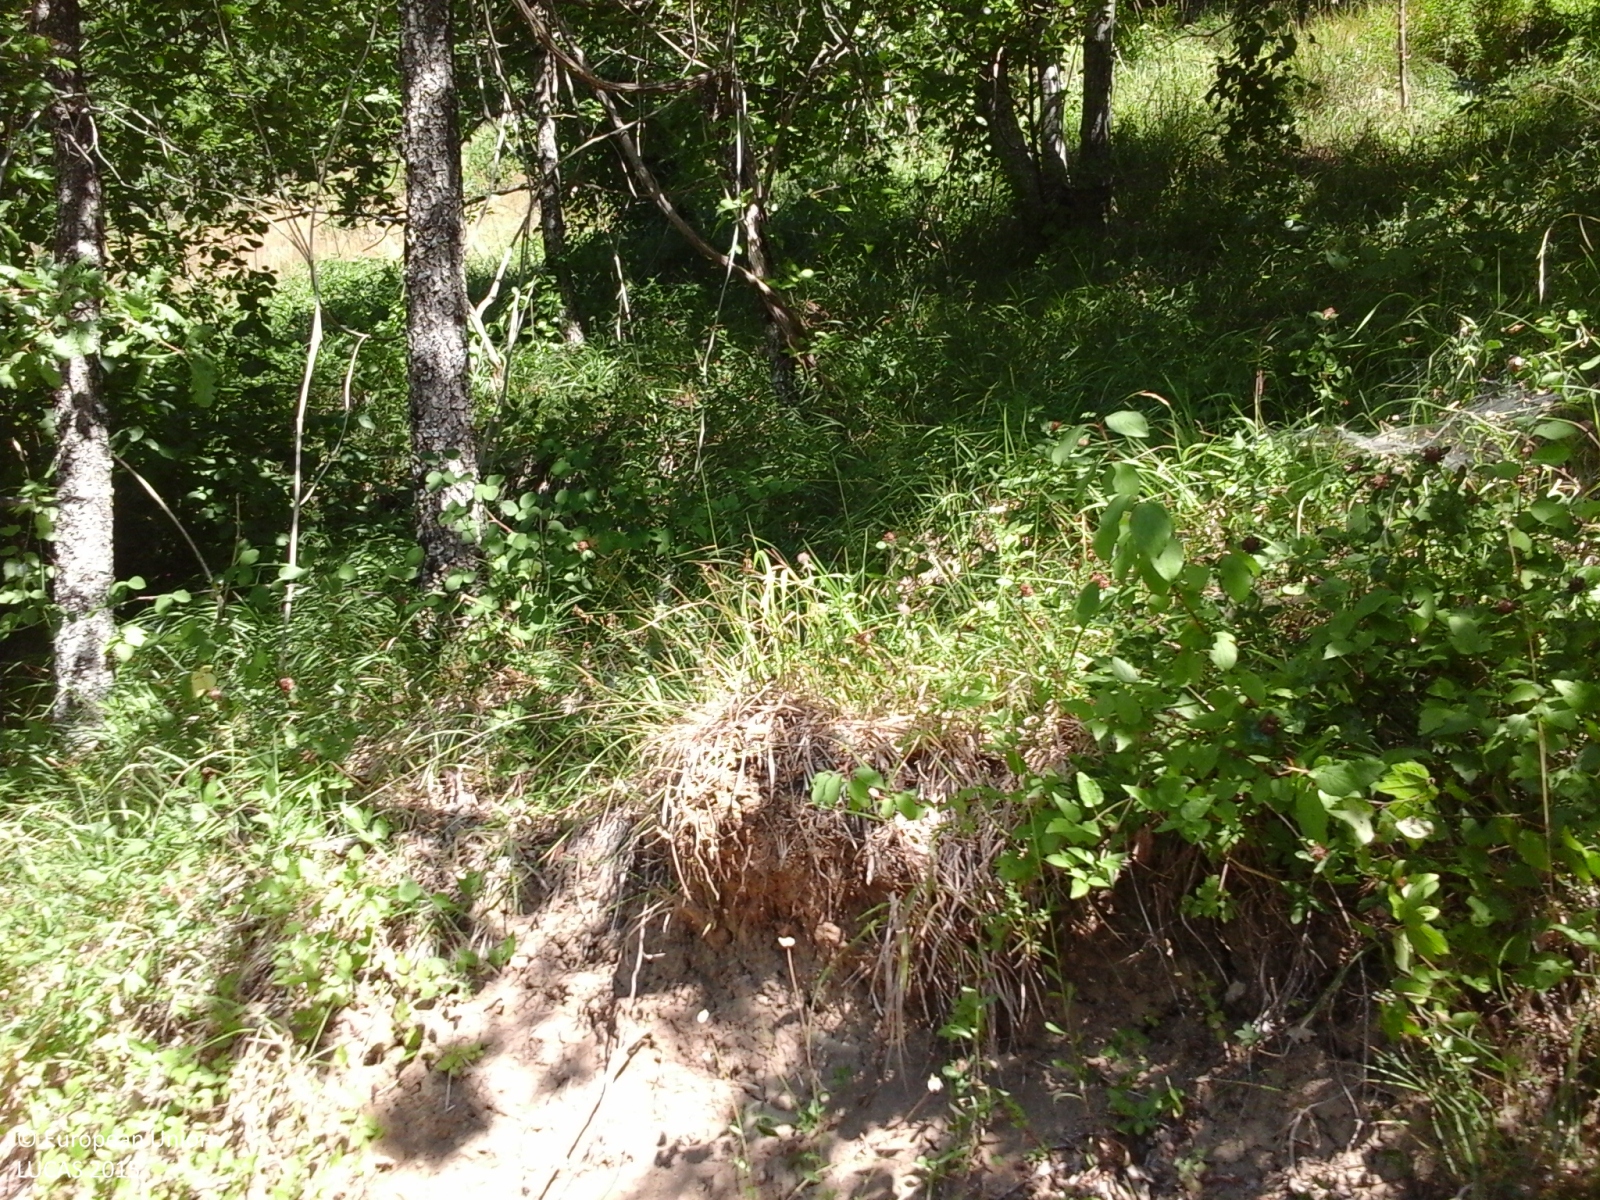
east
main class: Woodland
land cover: Broadleaved woodland
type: thermophilous deciduous forest
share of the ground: > 75 %
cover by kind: broadleaved forest trees 100 %
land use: Forestry
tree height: > 5 m
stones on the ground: < 10 %
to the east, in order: Broadleaved woodland; Grassland without tree/shrub cover; Broadleaved woodland; Tracks; Broadleaved woodland
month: August
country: IT
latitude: 43.5471
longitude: 12.3826
